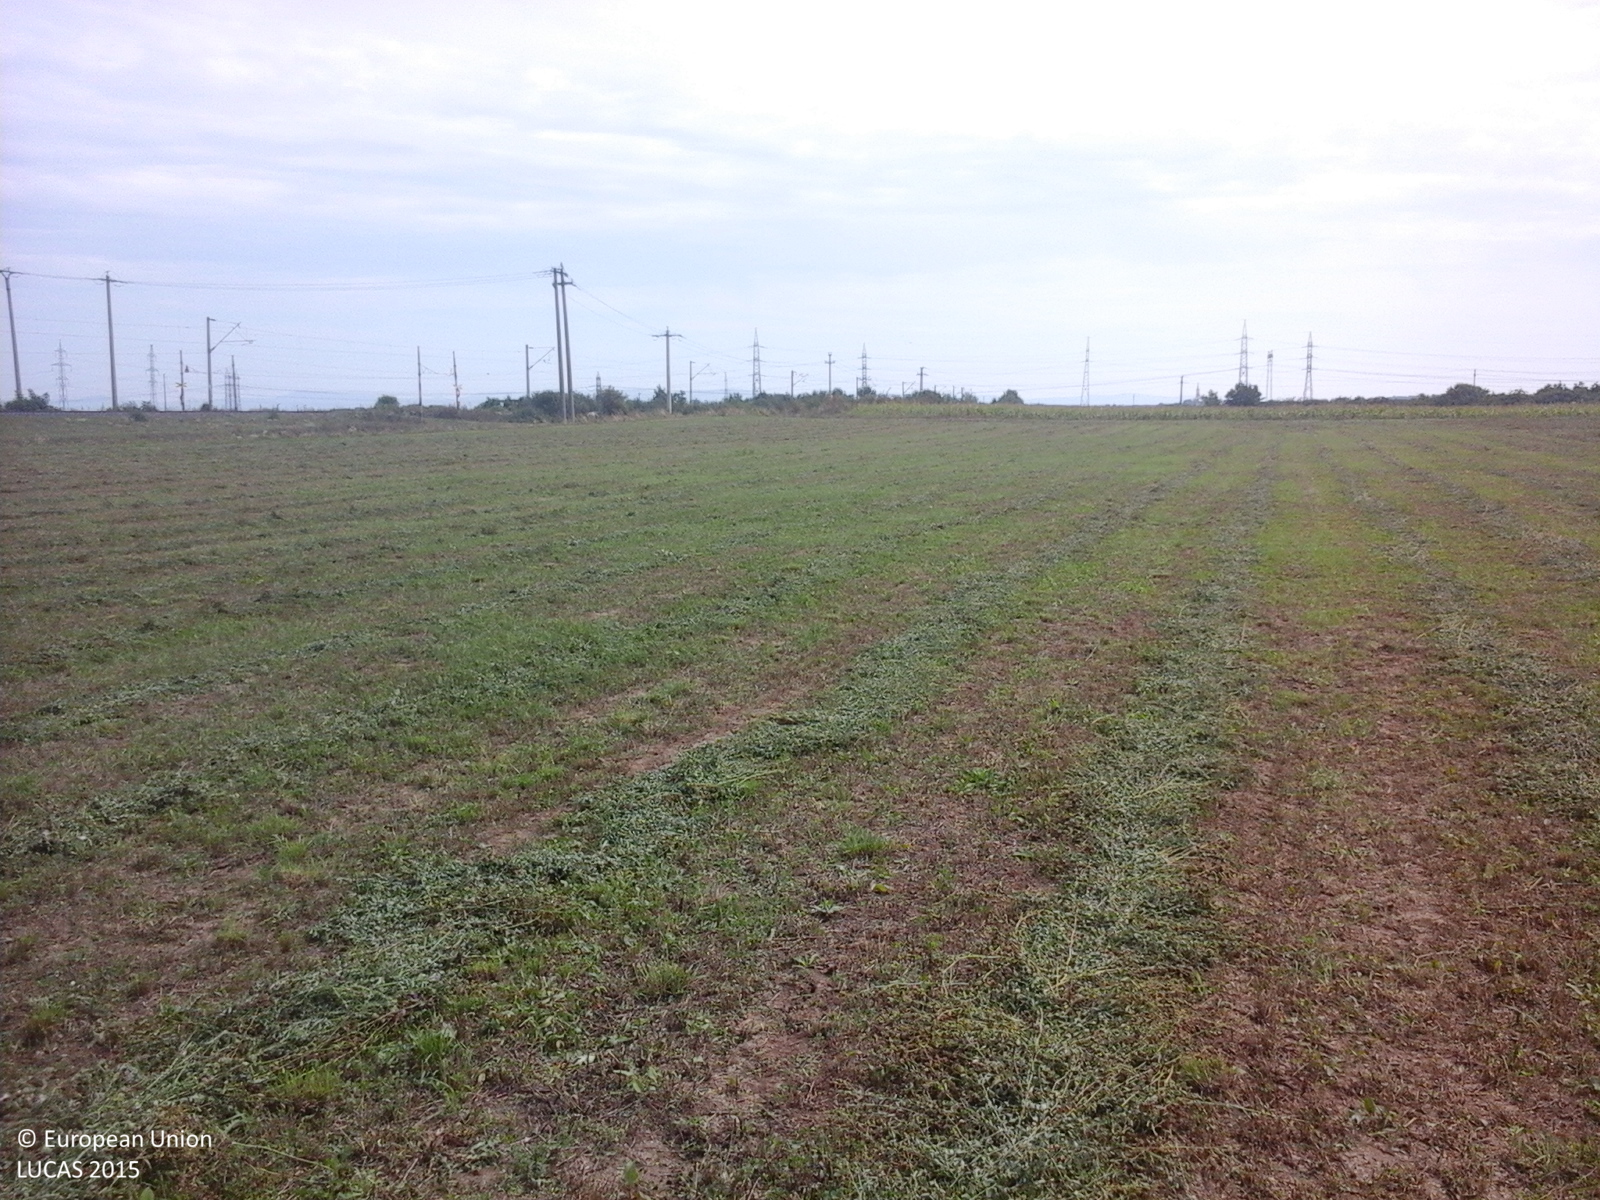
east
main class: Cropland
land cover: Lucerne
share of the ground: 50 - 75 %
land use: Agriculture (excluding fallow land and kitchen gardens)
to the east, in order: Lucerne; Tracks; Shrubland with sparse tree cover; Tracks; Grass margins; Maize; Shrubland with sparse tree cover; Ditches and canals; Grass margins; Electric lines; Grass margins; Tracks; Grass margins; Shrubland with sparse tree cover; Ditches and canals
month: August
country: RO
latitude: 46.1615
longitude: 21.3657
